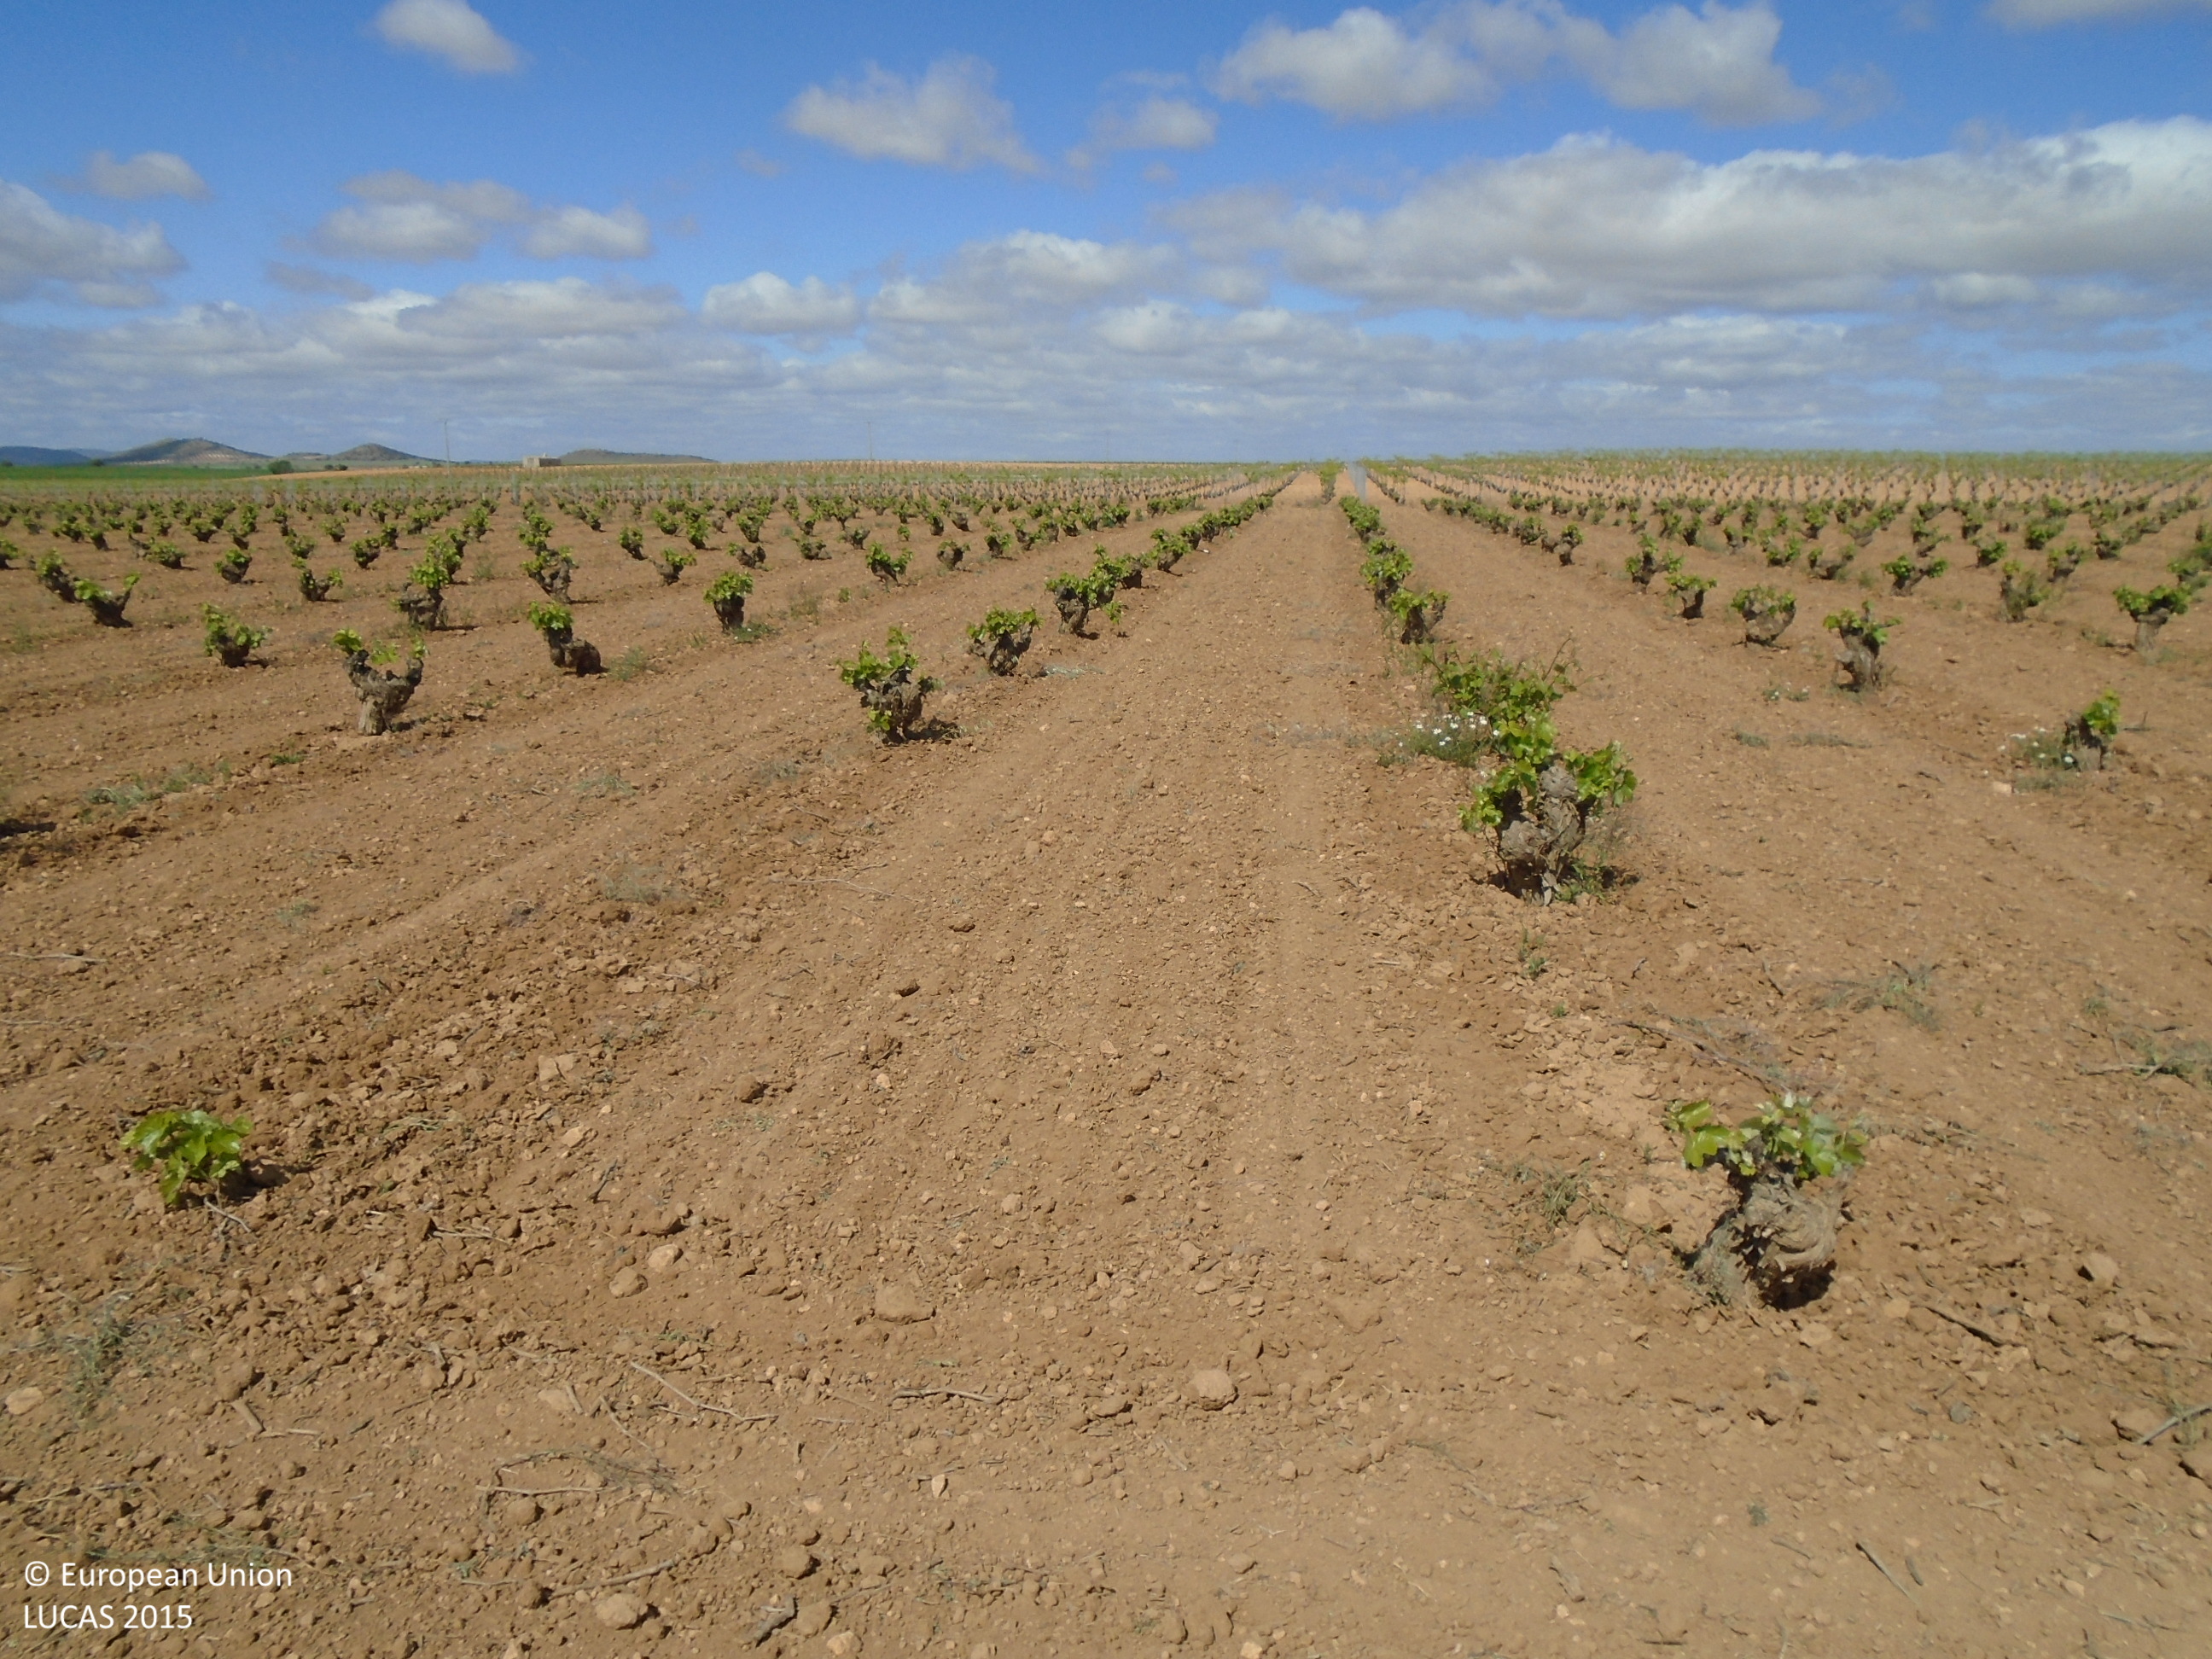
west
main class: Cropland
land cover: Vineyards
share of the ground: 10 - 25 %
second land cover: Other bare soil
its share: > 75 %
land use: Agriculture (excluding fallow land and kitchen gardens)
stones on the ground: < 10 %
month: May
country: ES
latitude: 39.5592
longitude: -3.5602
